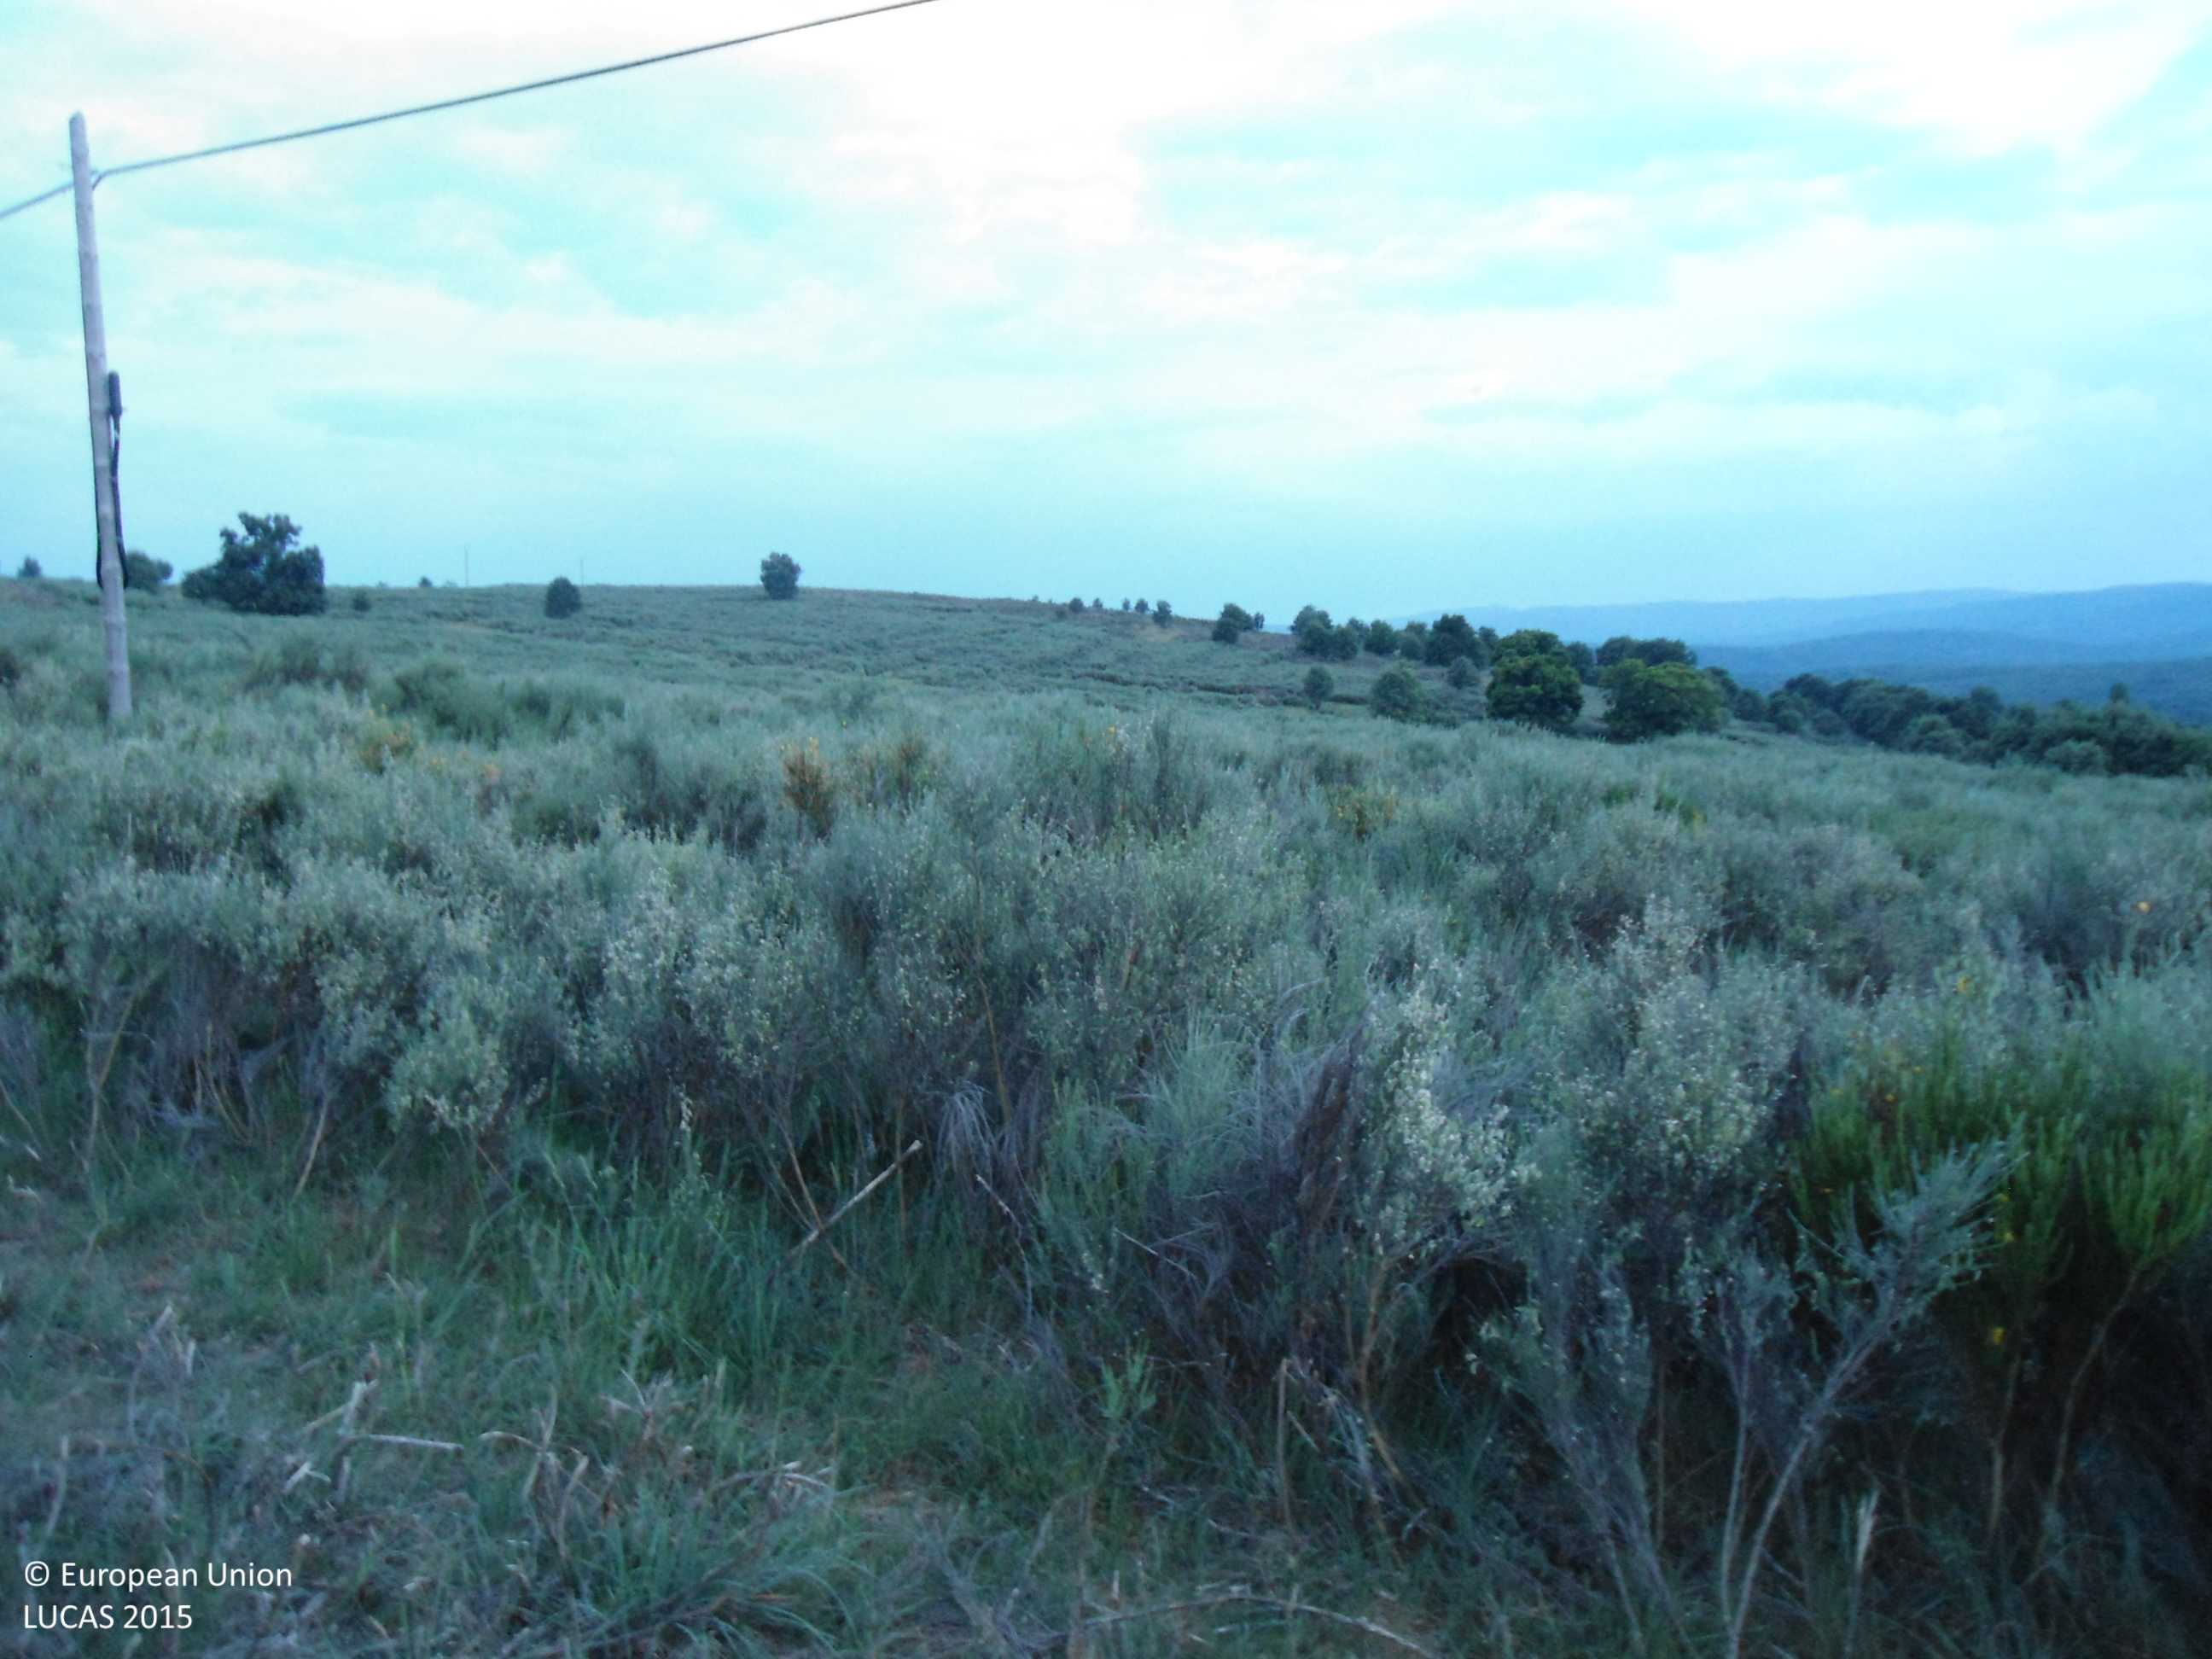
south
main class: Shrubland
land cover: Shrubland without tree cover
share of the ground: > 75 %
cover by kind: shrubs 100 %
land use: Semi-natural and natural areas not in use
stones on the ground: < 10 %
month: June
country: ES
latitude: 42.1505
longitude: -6.6334
